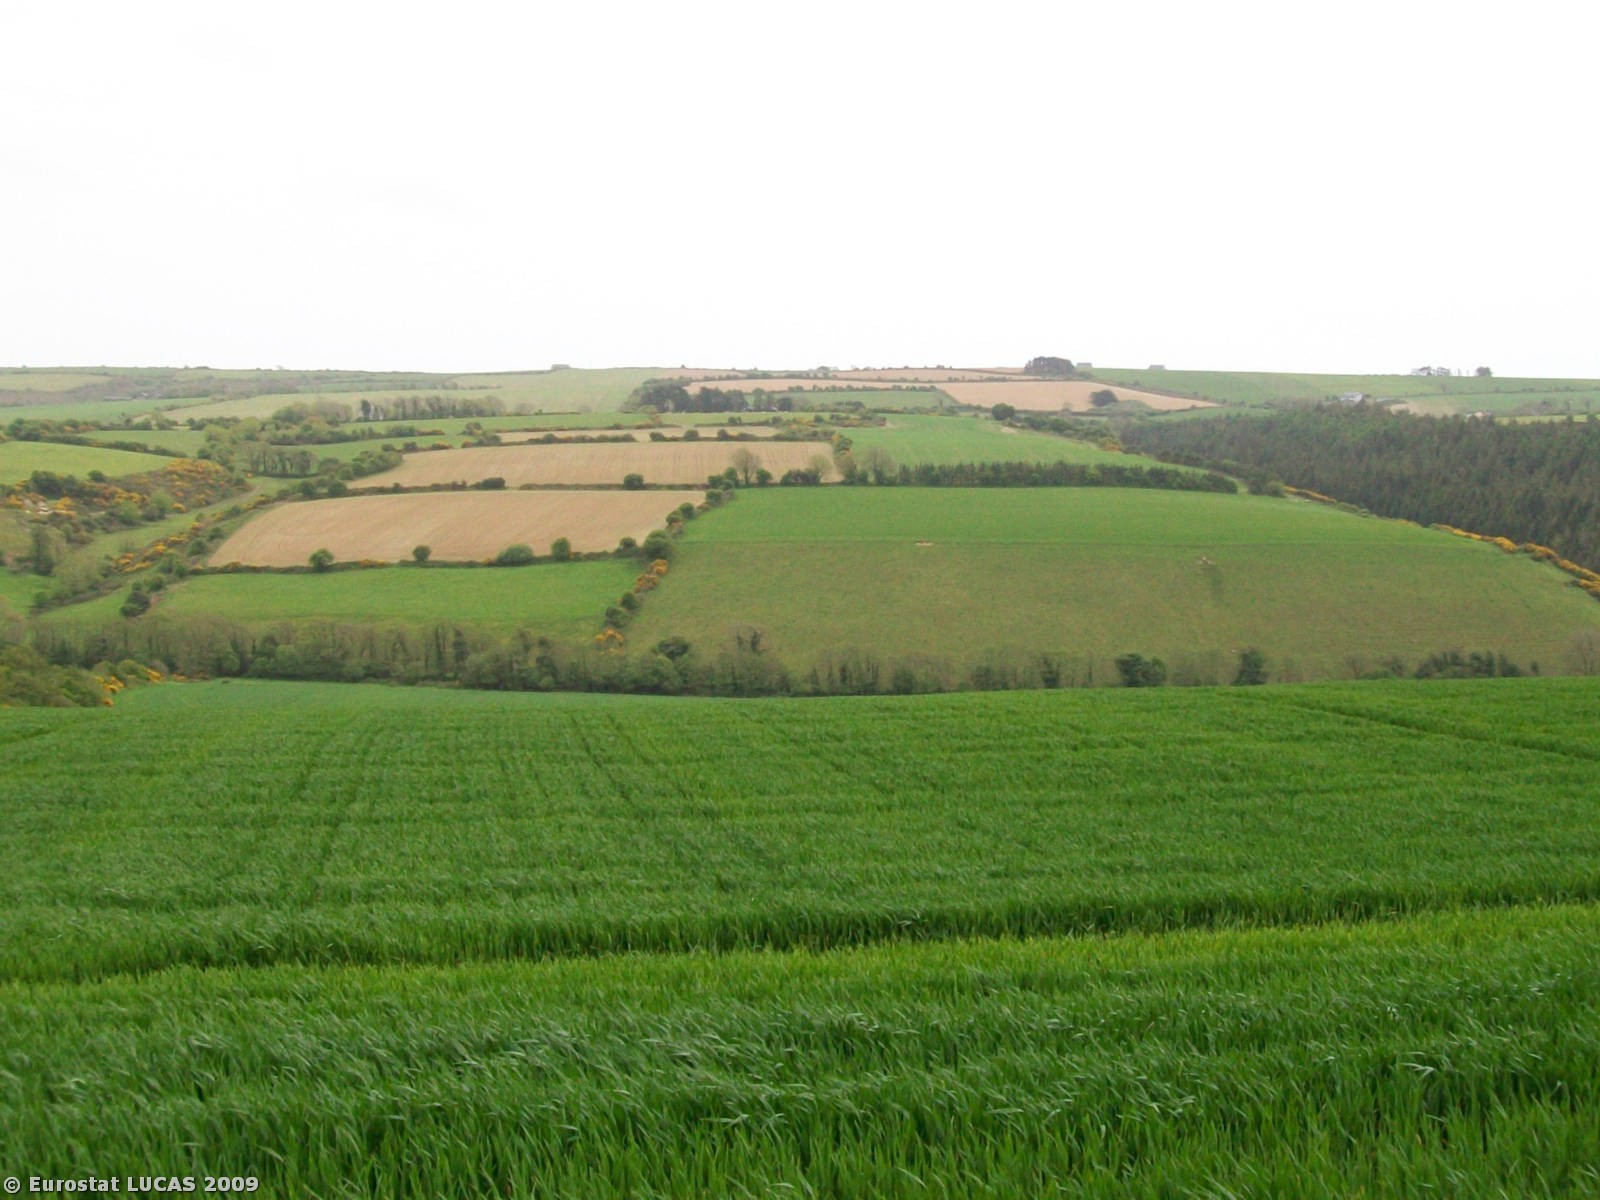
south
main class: Cropland
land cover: Common wheat
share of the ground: > 75 %
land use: Agriculture (excluding fallow land and kitchen gardens)
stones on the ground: < 10 %
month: May
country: IE
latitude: 51.7110
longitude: -8.6522
